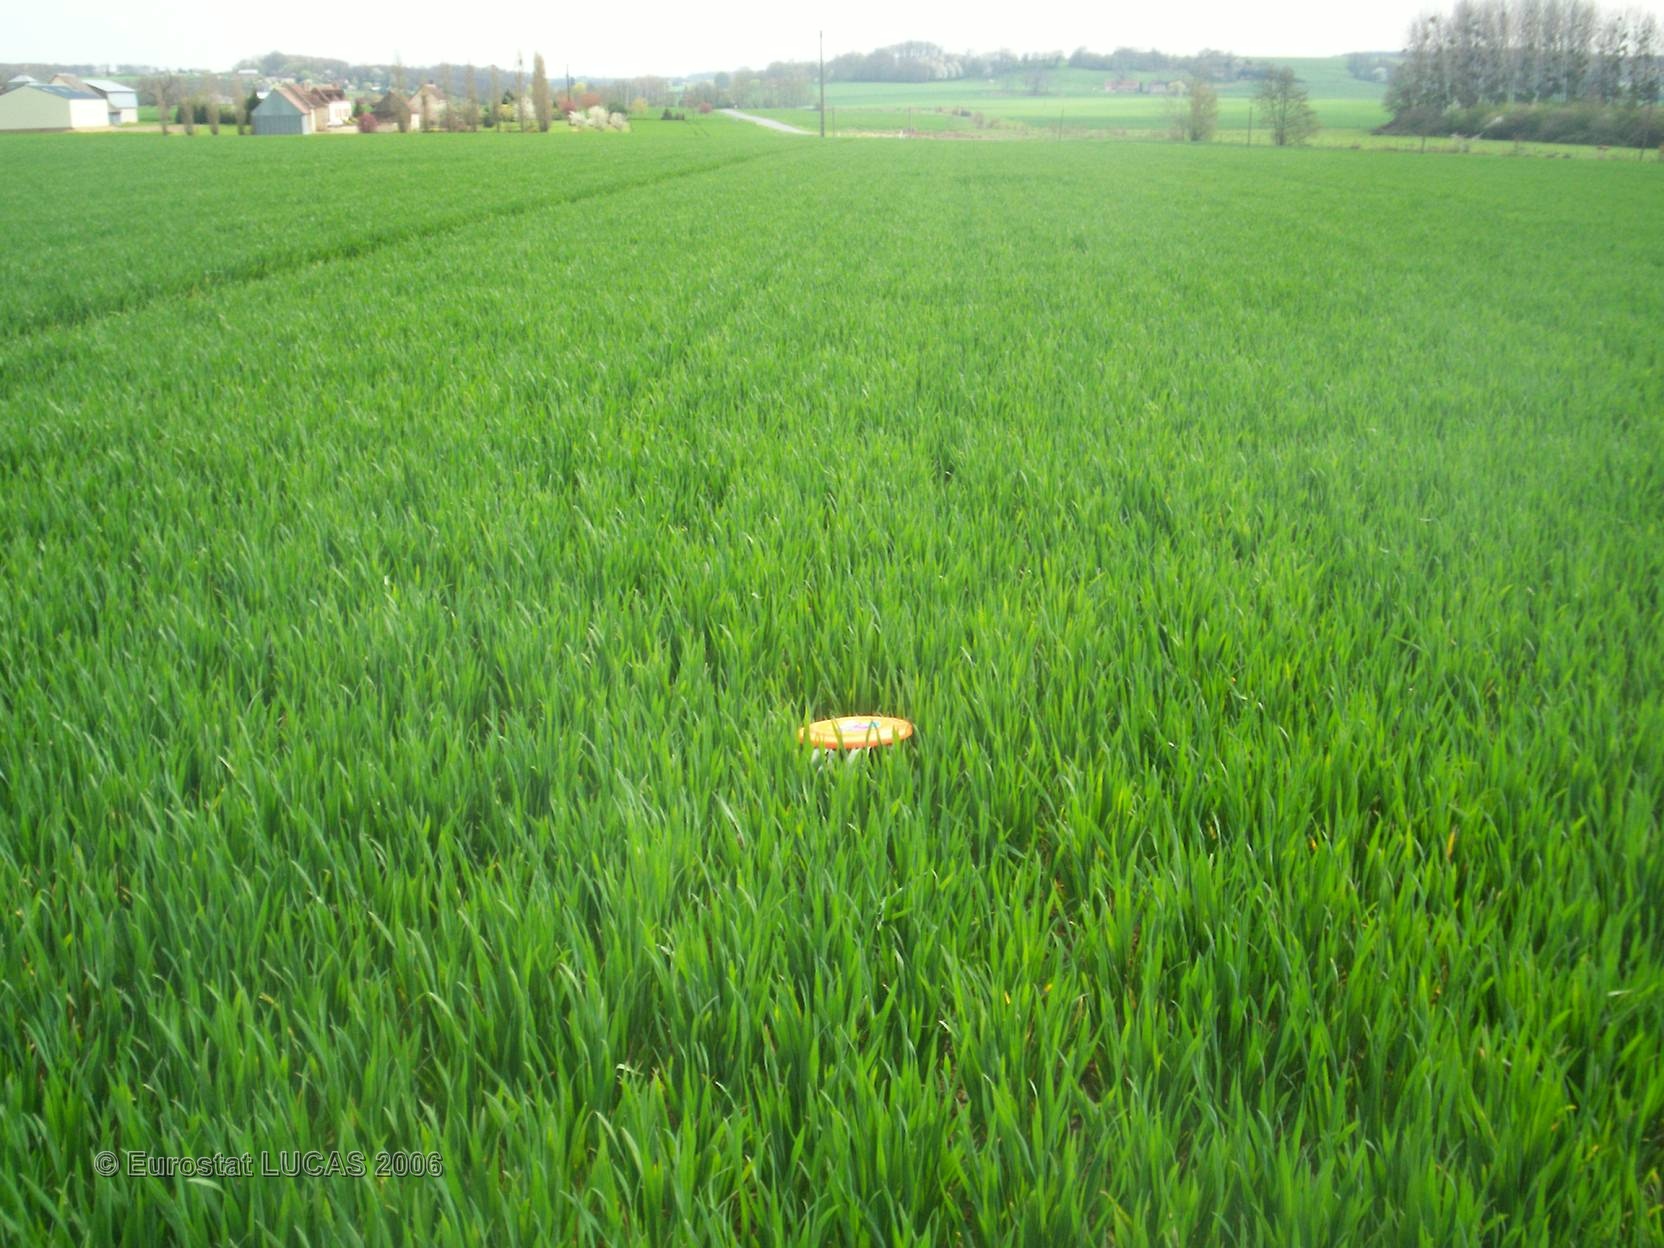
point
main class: Cropland
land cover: Common wheat
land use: Agriculture (excluding fallow land and kitchen gardens)
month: April
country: FR
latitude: 47.7490
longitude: 0.8169
